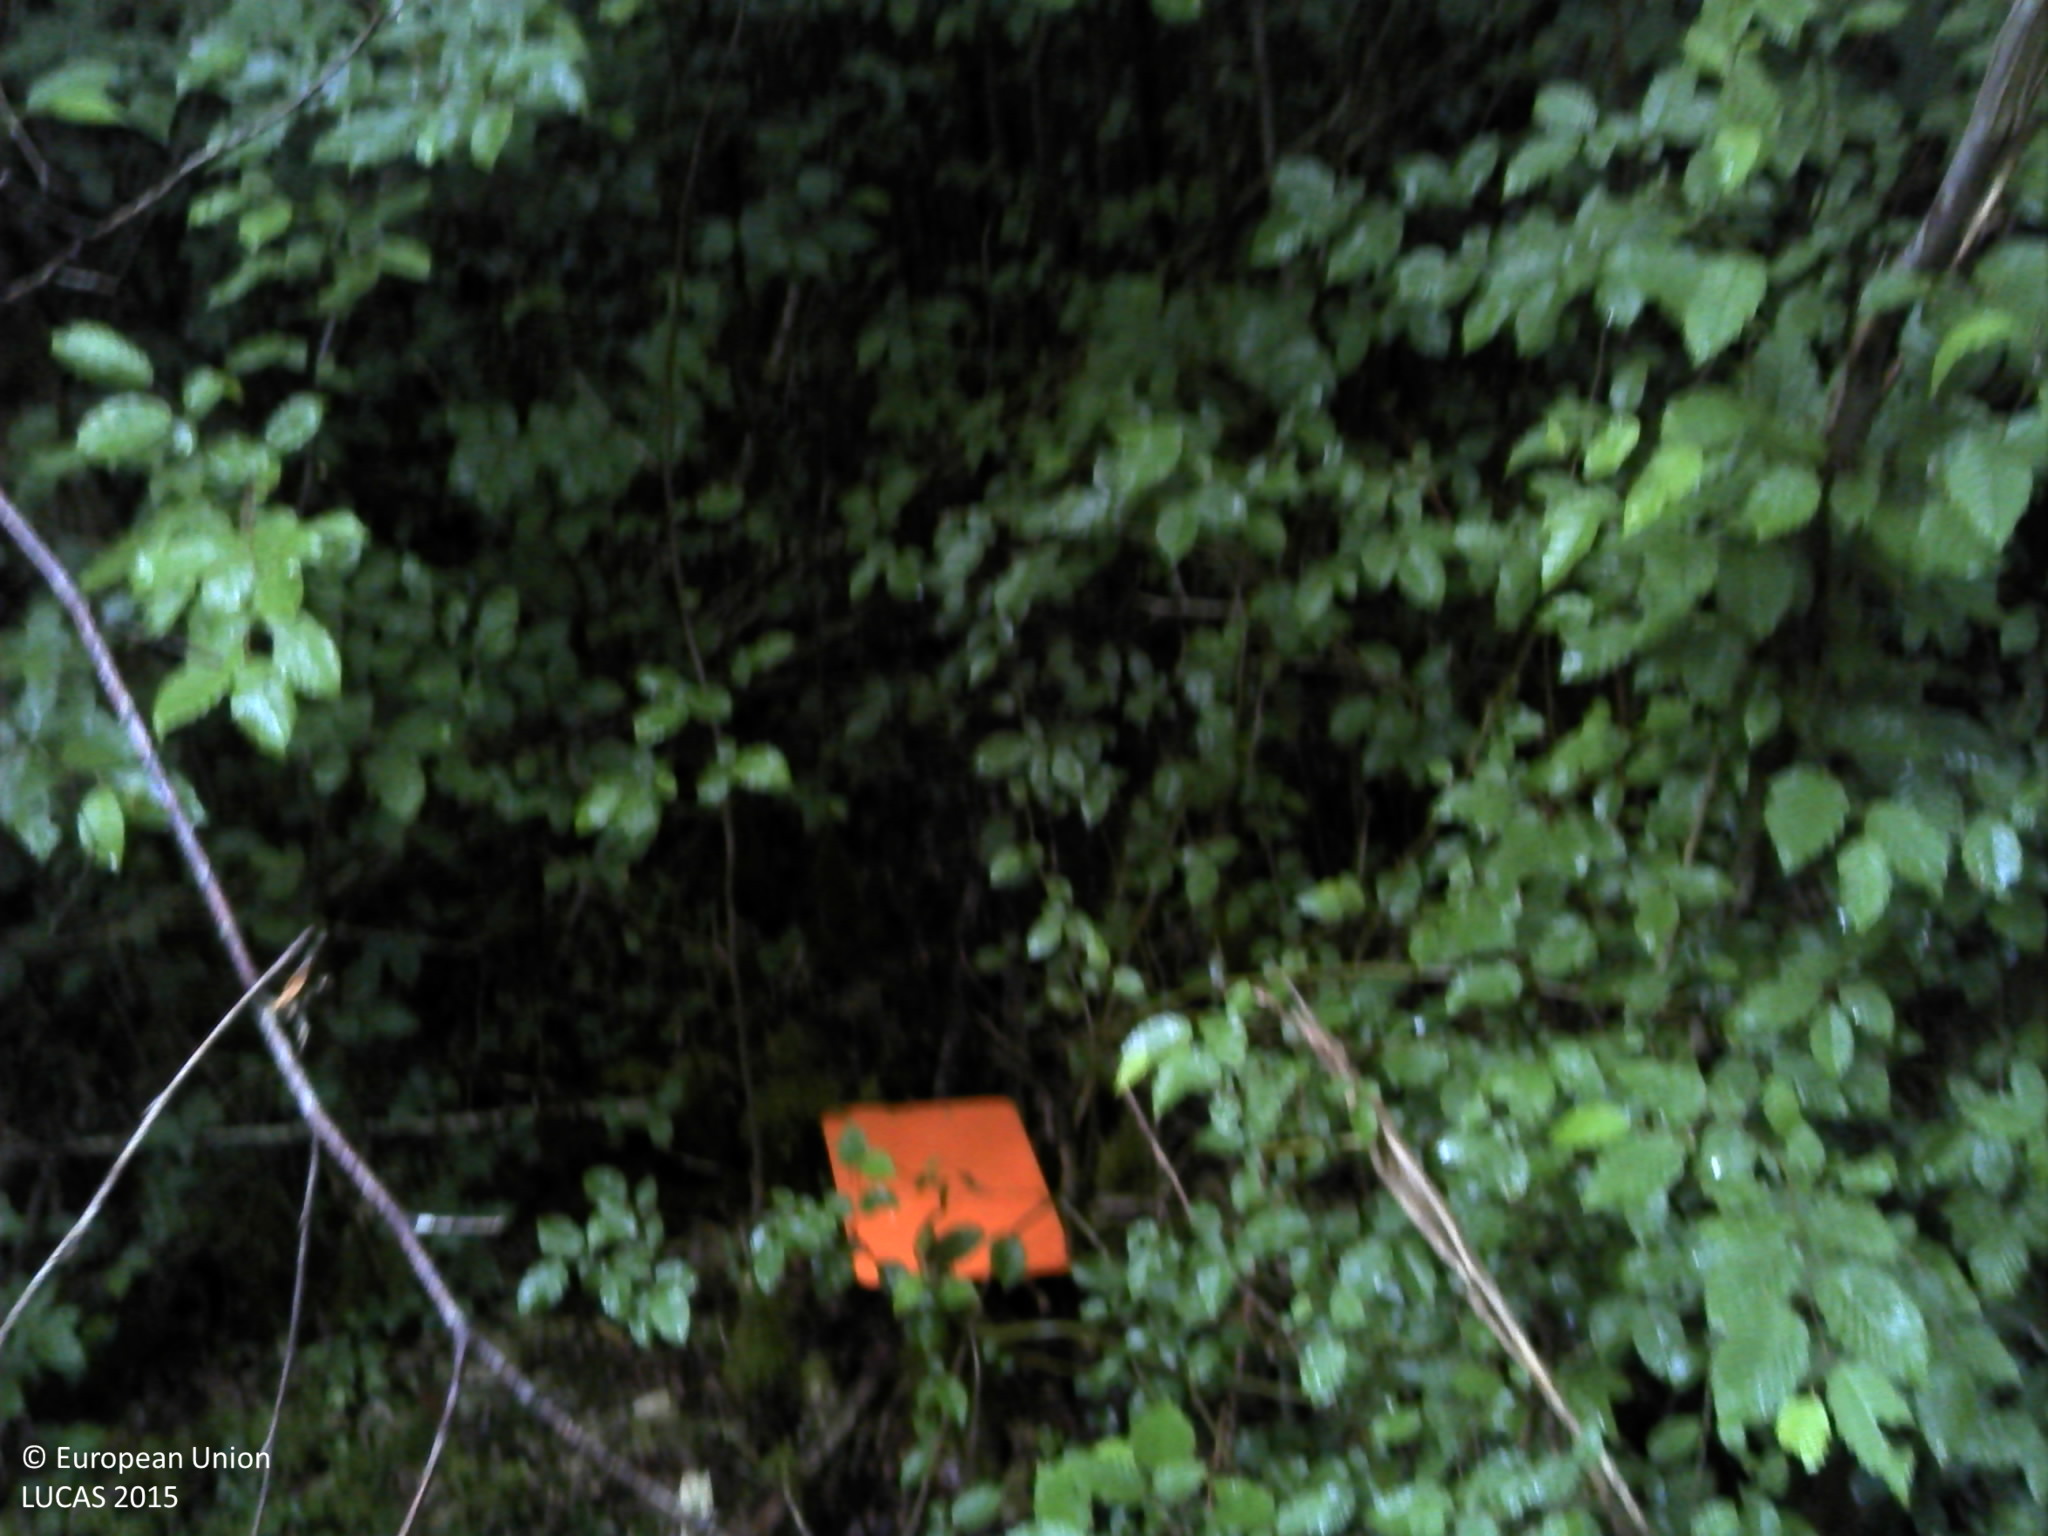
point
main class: Woodland
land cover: Broadleaved woodland
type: beech forest
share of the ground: > 75 %
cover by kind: broadleaved forest trees 85 %, herbaceous plants 5 %, lichens and mosses 5 %, consolidated bare surface 5 %
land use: Forestry
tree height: > 5 m
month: June
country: FR
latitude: 49.5345
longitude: 5.0093
